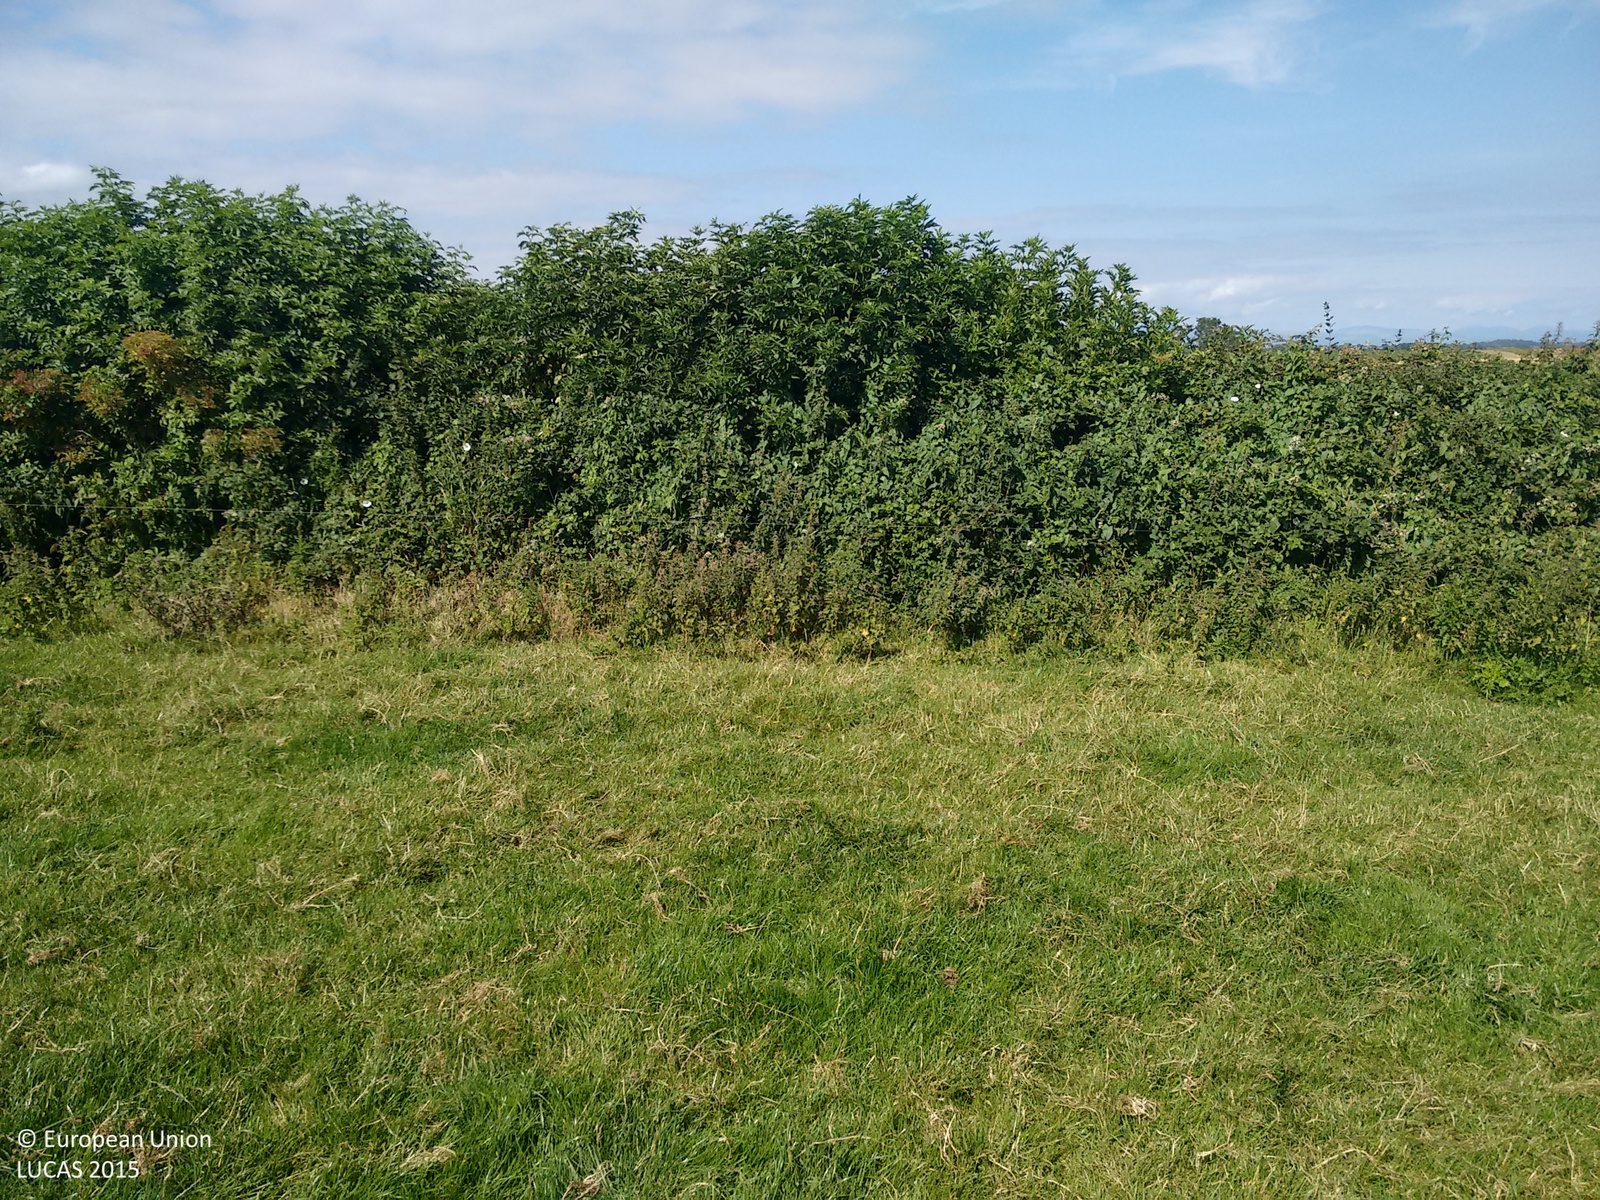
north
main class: Grassland
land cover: Grassland without tree/shrub cover
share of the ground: > 75 %
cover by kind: herbaceous plants 100 %
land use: Agriculture (excluding fallow land and kitchen gardens)
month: August
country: IE
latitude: 53.8120
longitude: -6.2945
